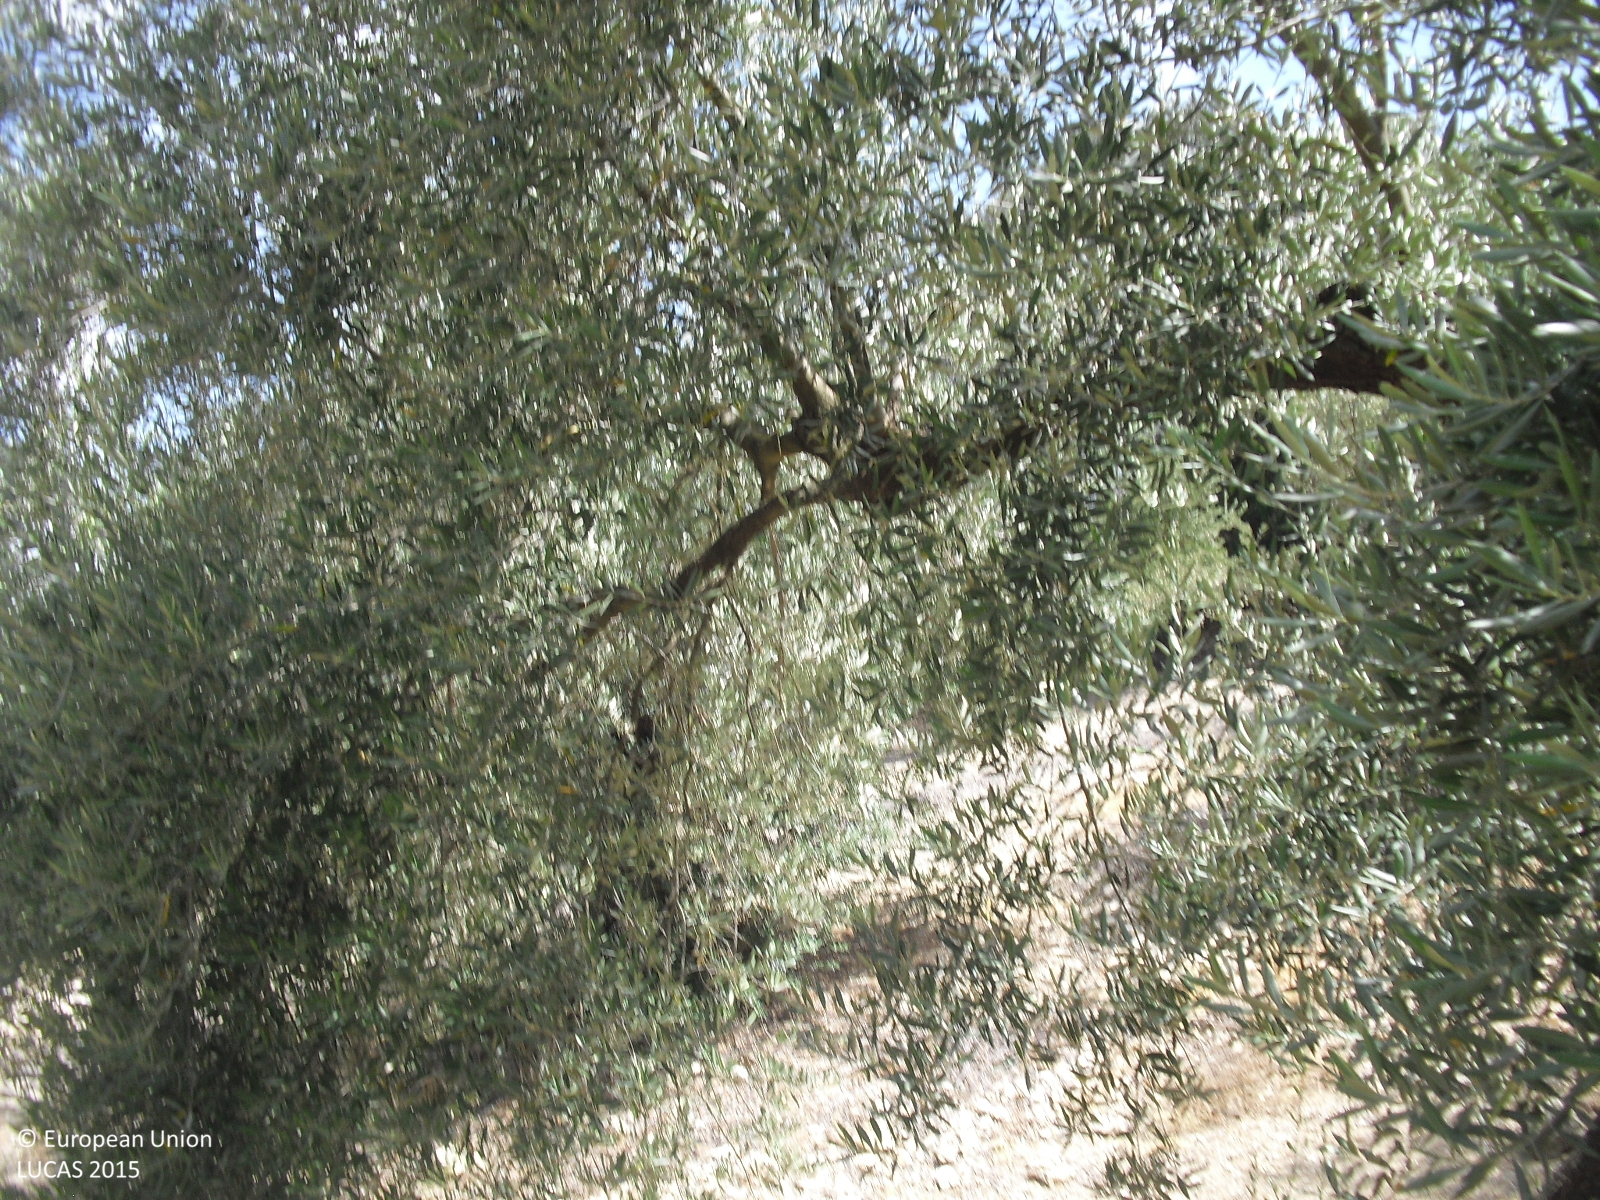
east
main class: Cropland
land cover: Olive groves
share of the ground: 50 - 75 %
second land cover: Other bare soil
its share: > 75 %
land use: Agriculture (excluding fallow land and kitchen gardens)
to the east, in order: Olive groves; Other bare soil; Broadleaved woodland; Olive groves; Electric lines; Olive groves; Grassland without tree/shrub cover; Tracks; Grassland without tree/shrub cover; Tracks; Other bare soil; Ditches and canals; Paved roads, cycling and walking lanes; Olive groves; Broadleaved woodland
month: July
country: ES
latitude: 37.4278
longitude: -4.0902
